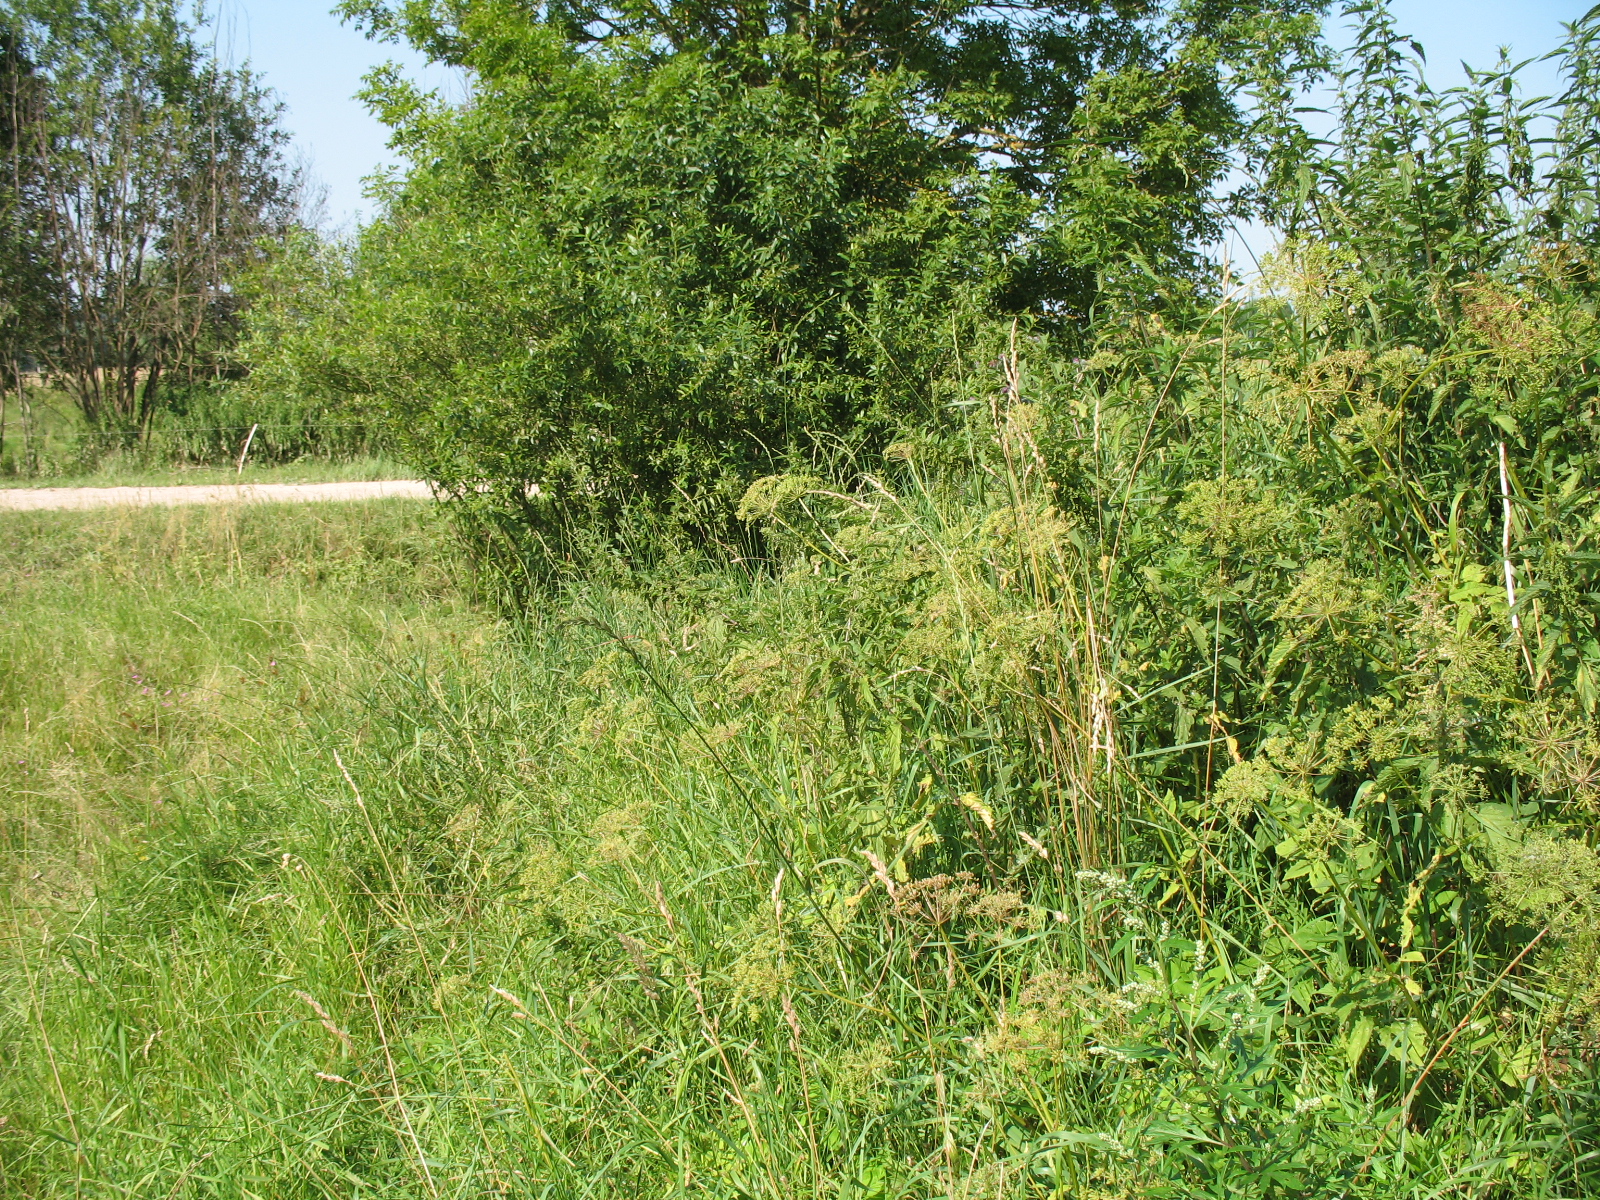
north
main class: Grassland
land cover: Grassland without tree/shrub cover
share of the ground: > 75 %
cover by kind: herbaceous plants 95 %, shrubs 5 %
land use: Agriculture (excluding fallow land and kitchen gardens)
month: August
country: LV
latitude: 56.4545
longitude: 25.4526
